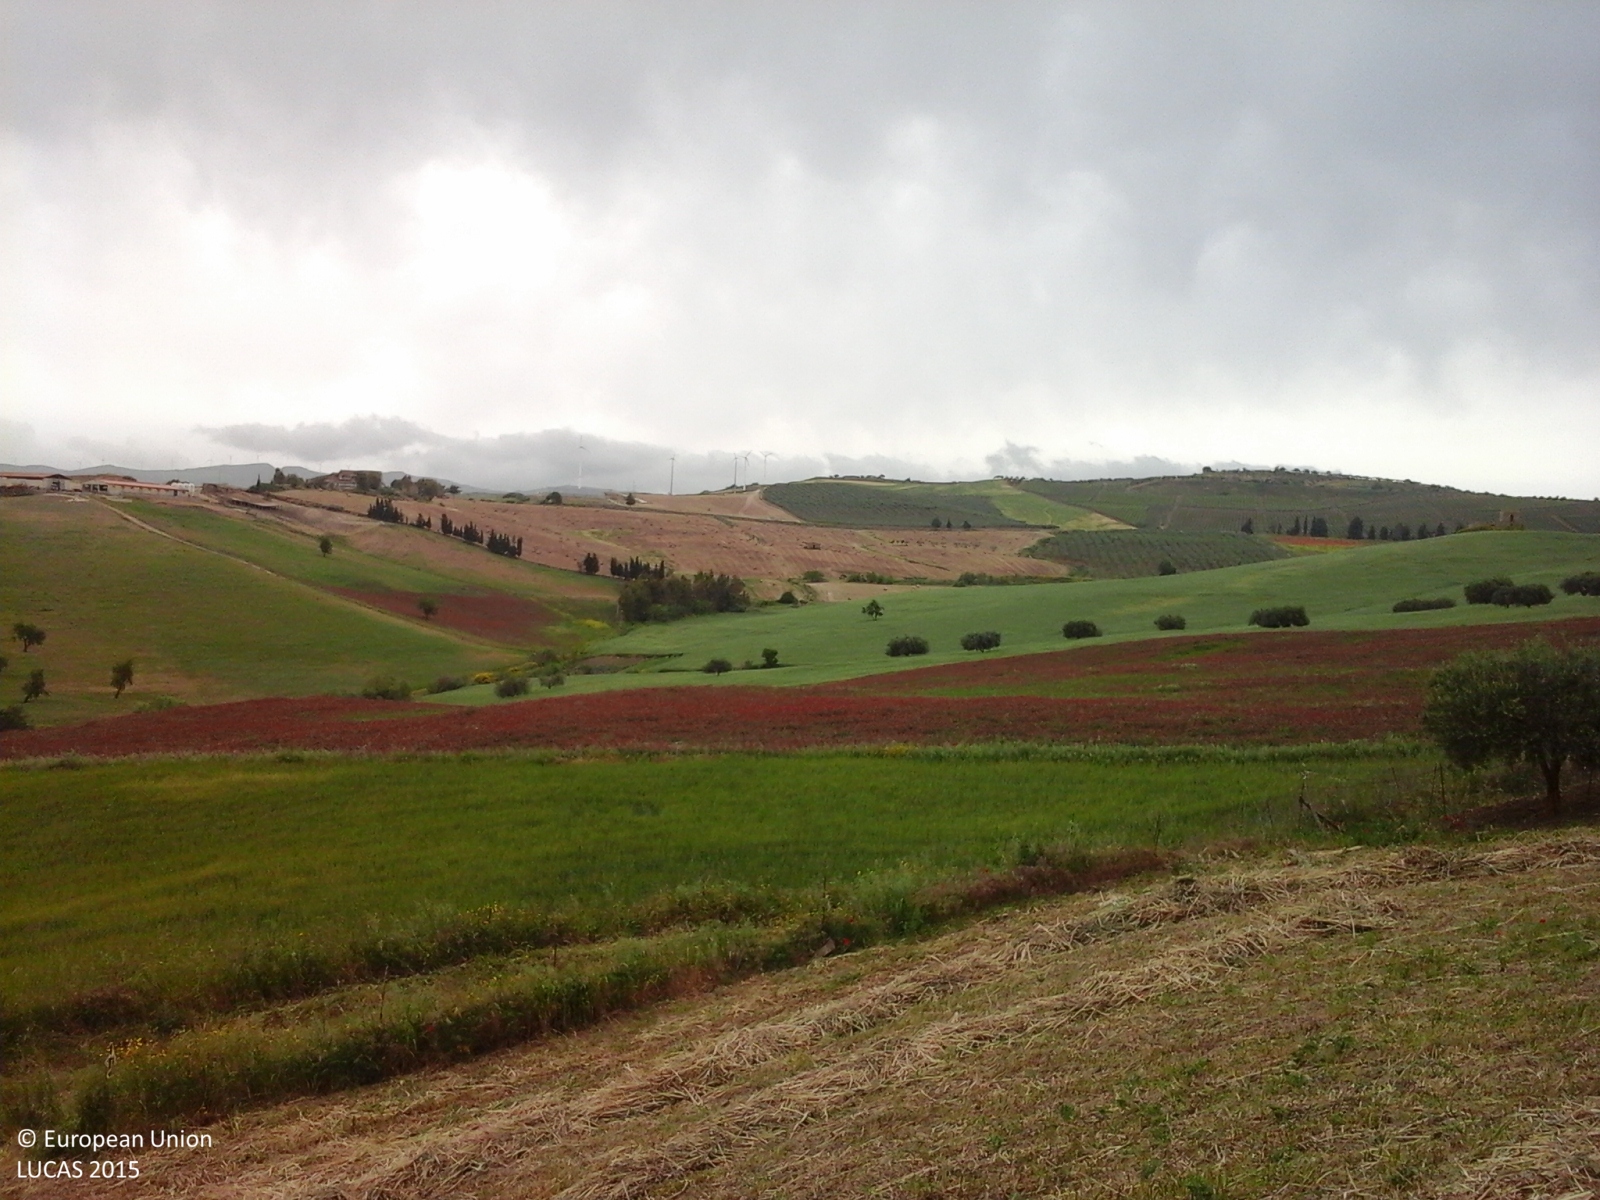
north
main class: Cropland
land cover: Temporary grasslands
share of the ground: > 75 %
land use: Agriculture (excluding fallow land and kitchen gardens)
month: May
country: IT
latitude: 37.6719
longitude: 13.7929
